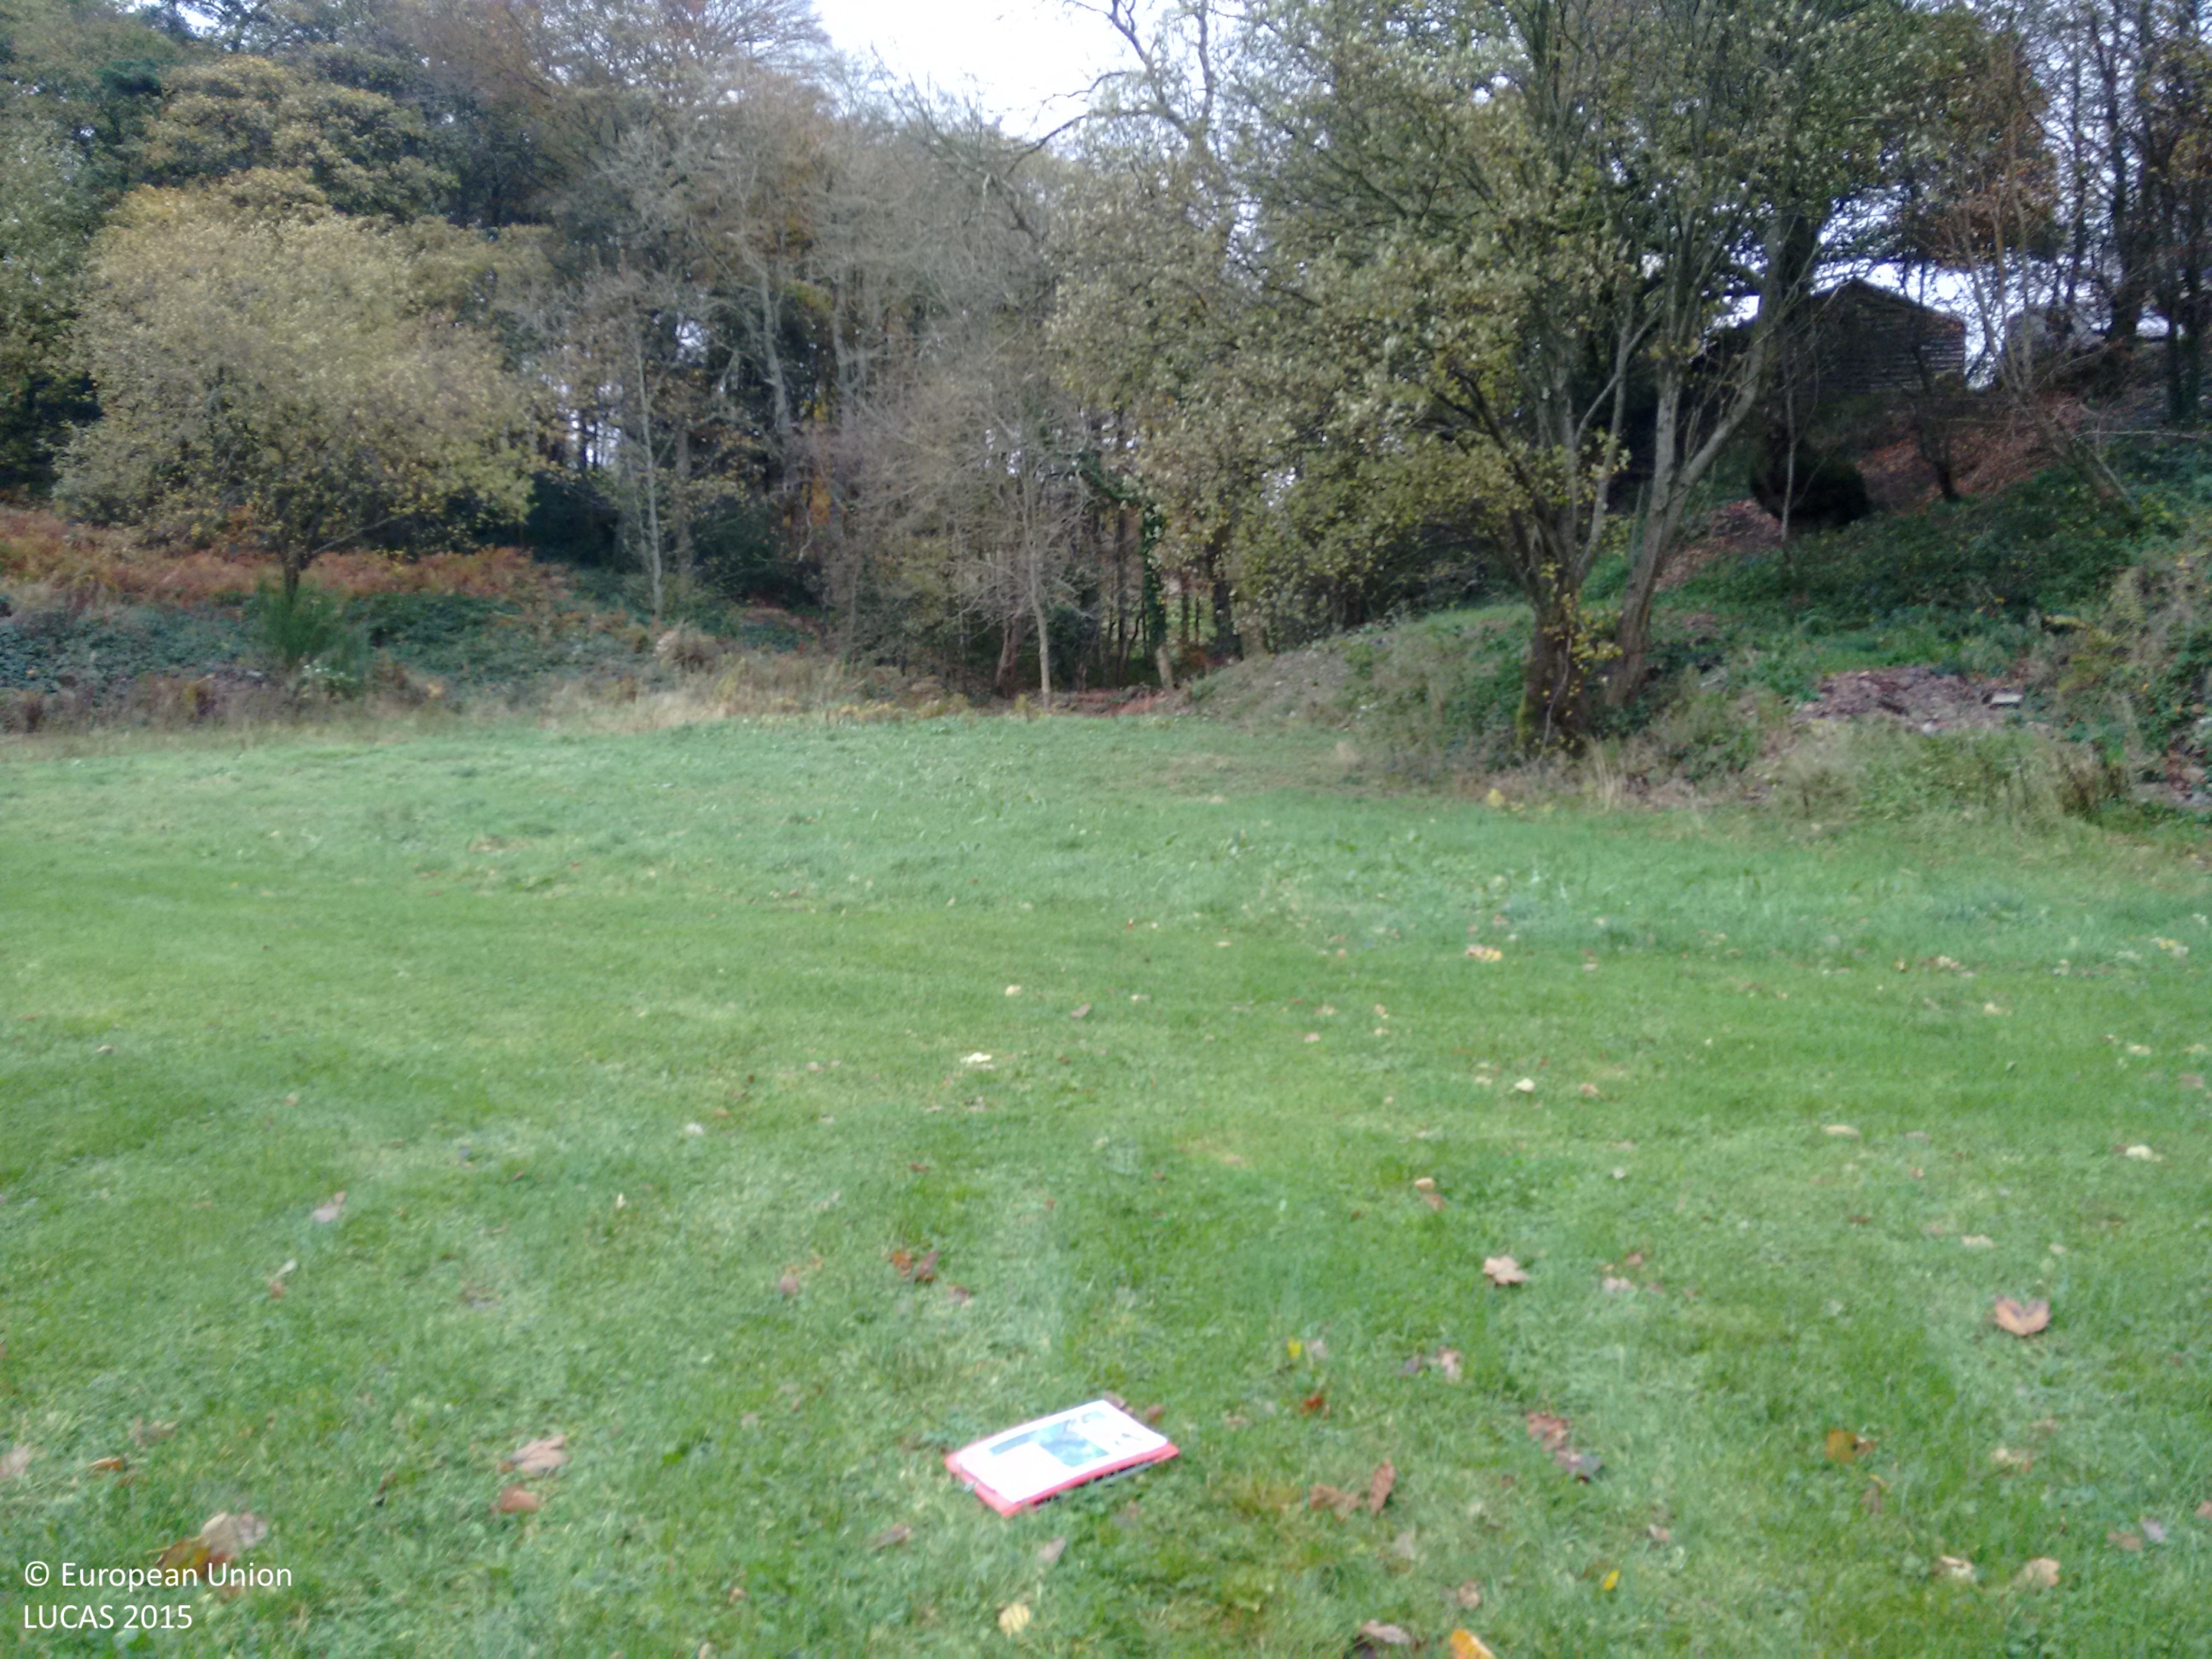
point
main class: Grassland
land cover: Grassland without tree/shrub cover
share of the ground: > 75 %
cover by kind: herbaceous plants 100 %
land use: Sport
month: November
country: GB
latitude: 54.2788
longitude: -3.2083
